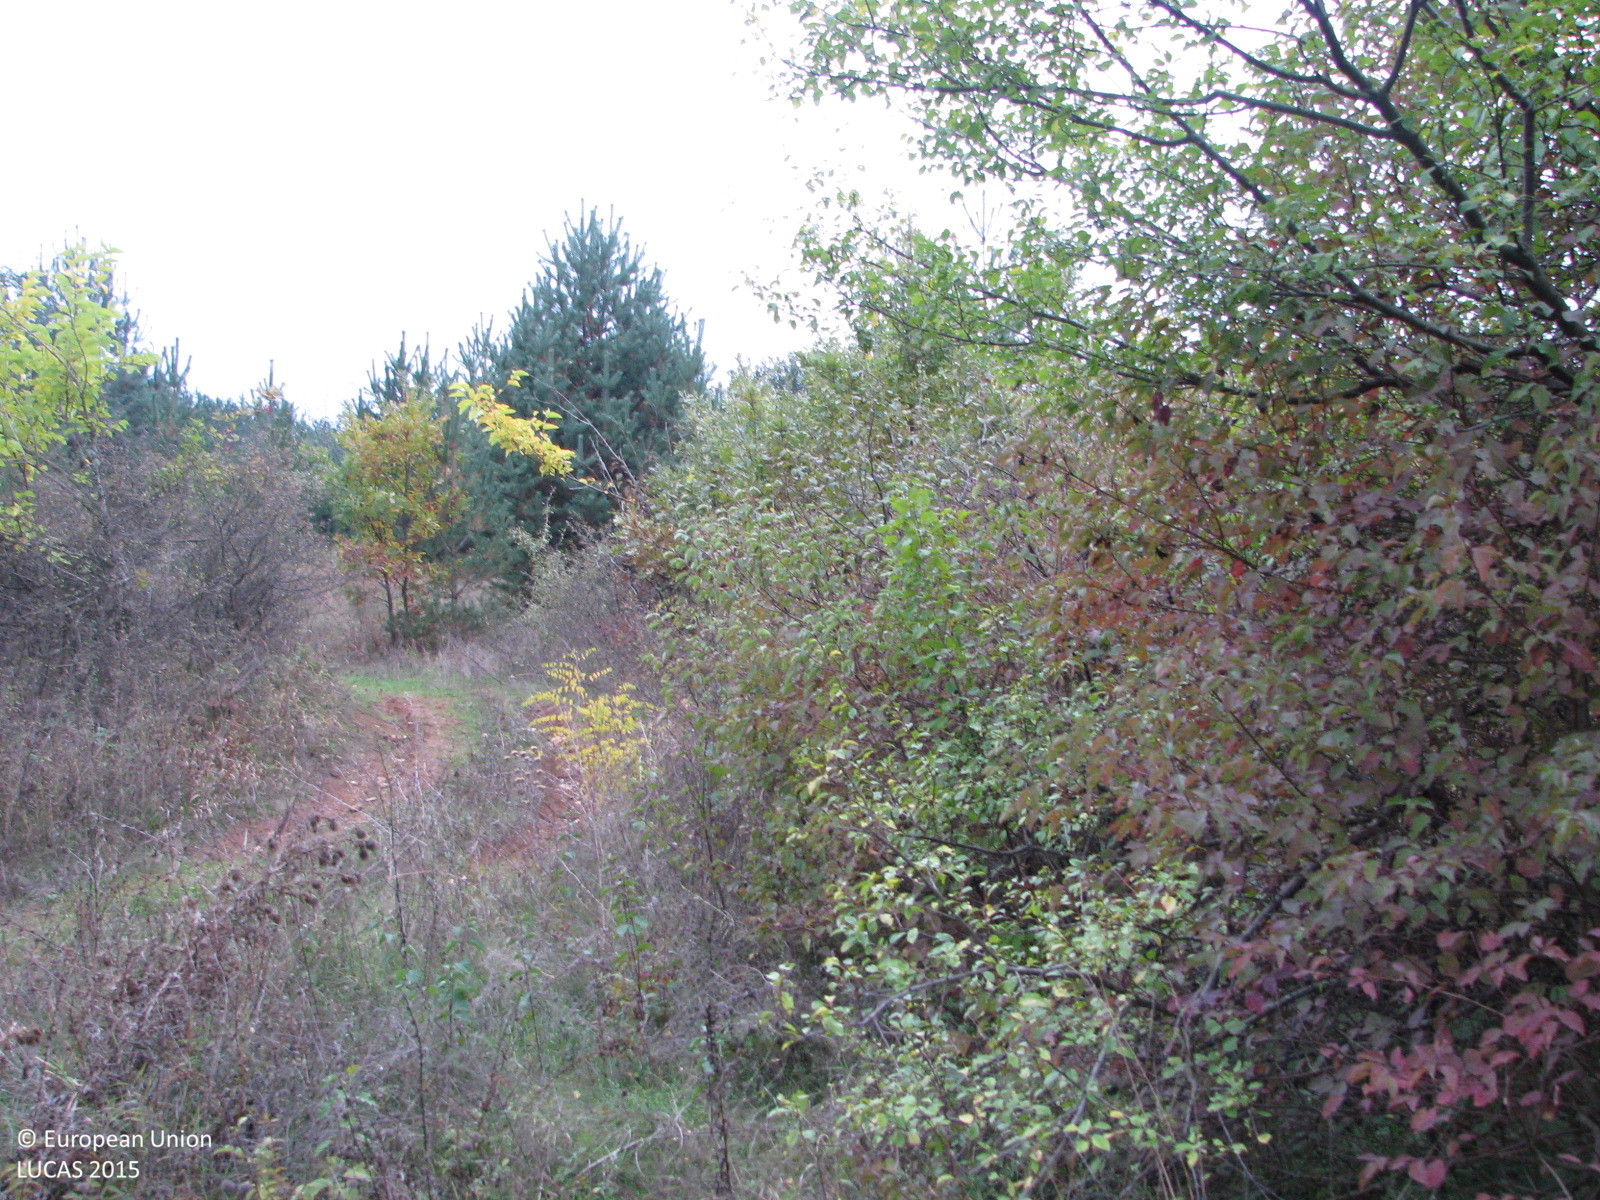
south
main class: Woodland
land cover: Broadleaved woodland
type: mesophytic deciduous forest
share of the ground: 25 - 50 %
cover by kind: broadleaved forest trees 45 %, herbaceous plants 40 %, shrubs 15 %
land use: Semi-natural and natural areas not in use
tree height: < 5 m
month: October
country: BG
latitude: 42.0746
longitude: 26.3152
